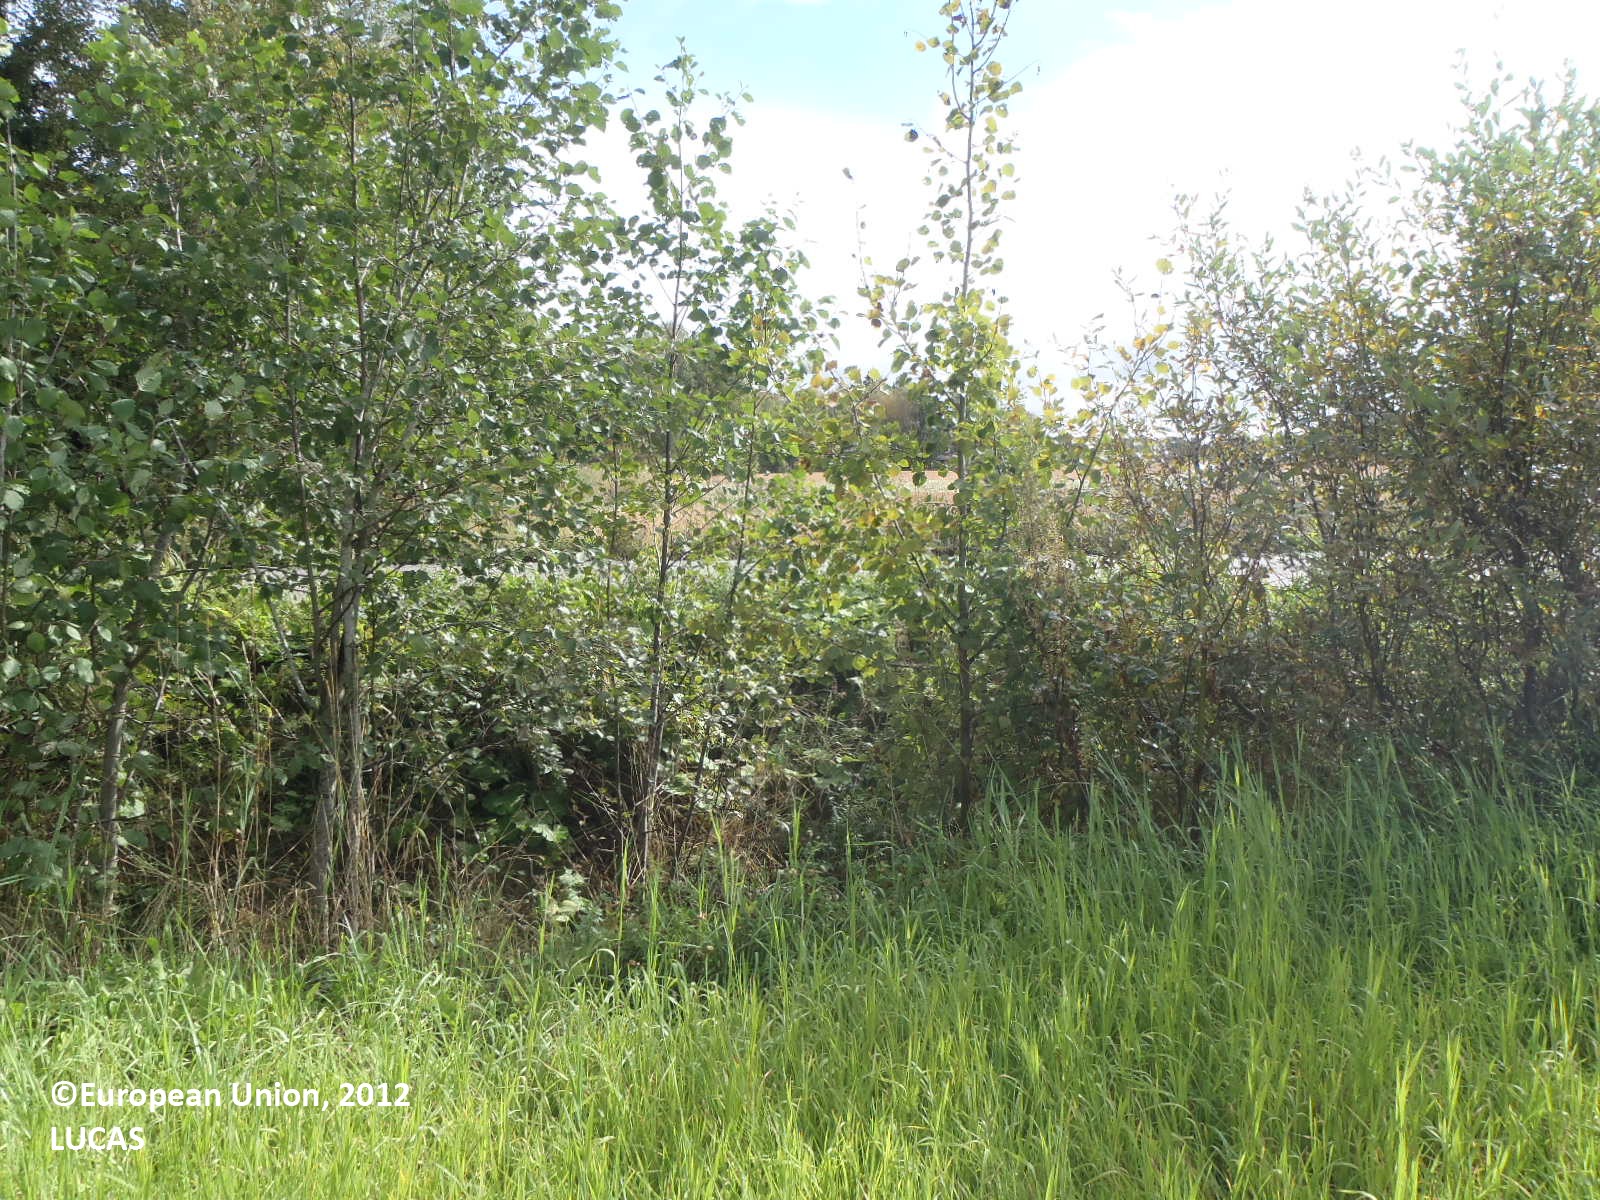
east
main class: Cropland
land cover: Temporary grasslands
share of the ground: > 75 %
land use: Agriculture (excluding fallow land and kitchen gardens)
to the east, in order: Temporary grasslands; Grass margins; Ditches and canals; Abandoned hedges; Grass margins; Paved roads, cycling and walking lanes; Grass margins; Ditches and canals; Grass margins; Grassland with sparse tree/shrub cover; Rocks and stones; Paved roads, cycling and walking lanes; Grass margins; Pine dominated mixed woodland; Paved roads, cycling and walking lanes; Grass margins; Ditches and canals; Broadleaved woodland; Barley
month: September
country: FI
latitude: 61.0668
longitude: 22.6881
